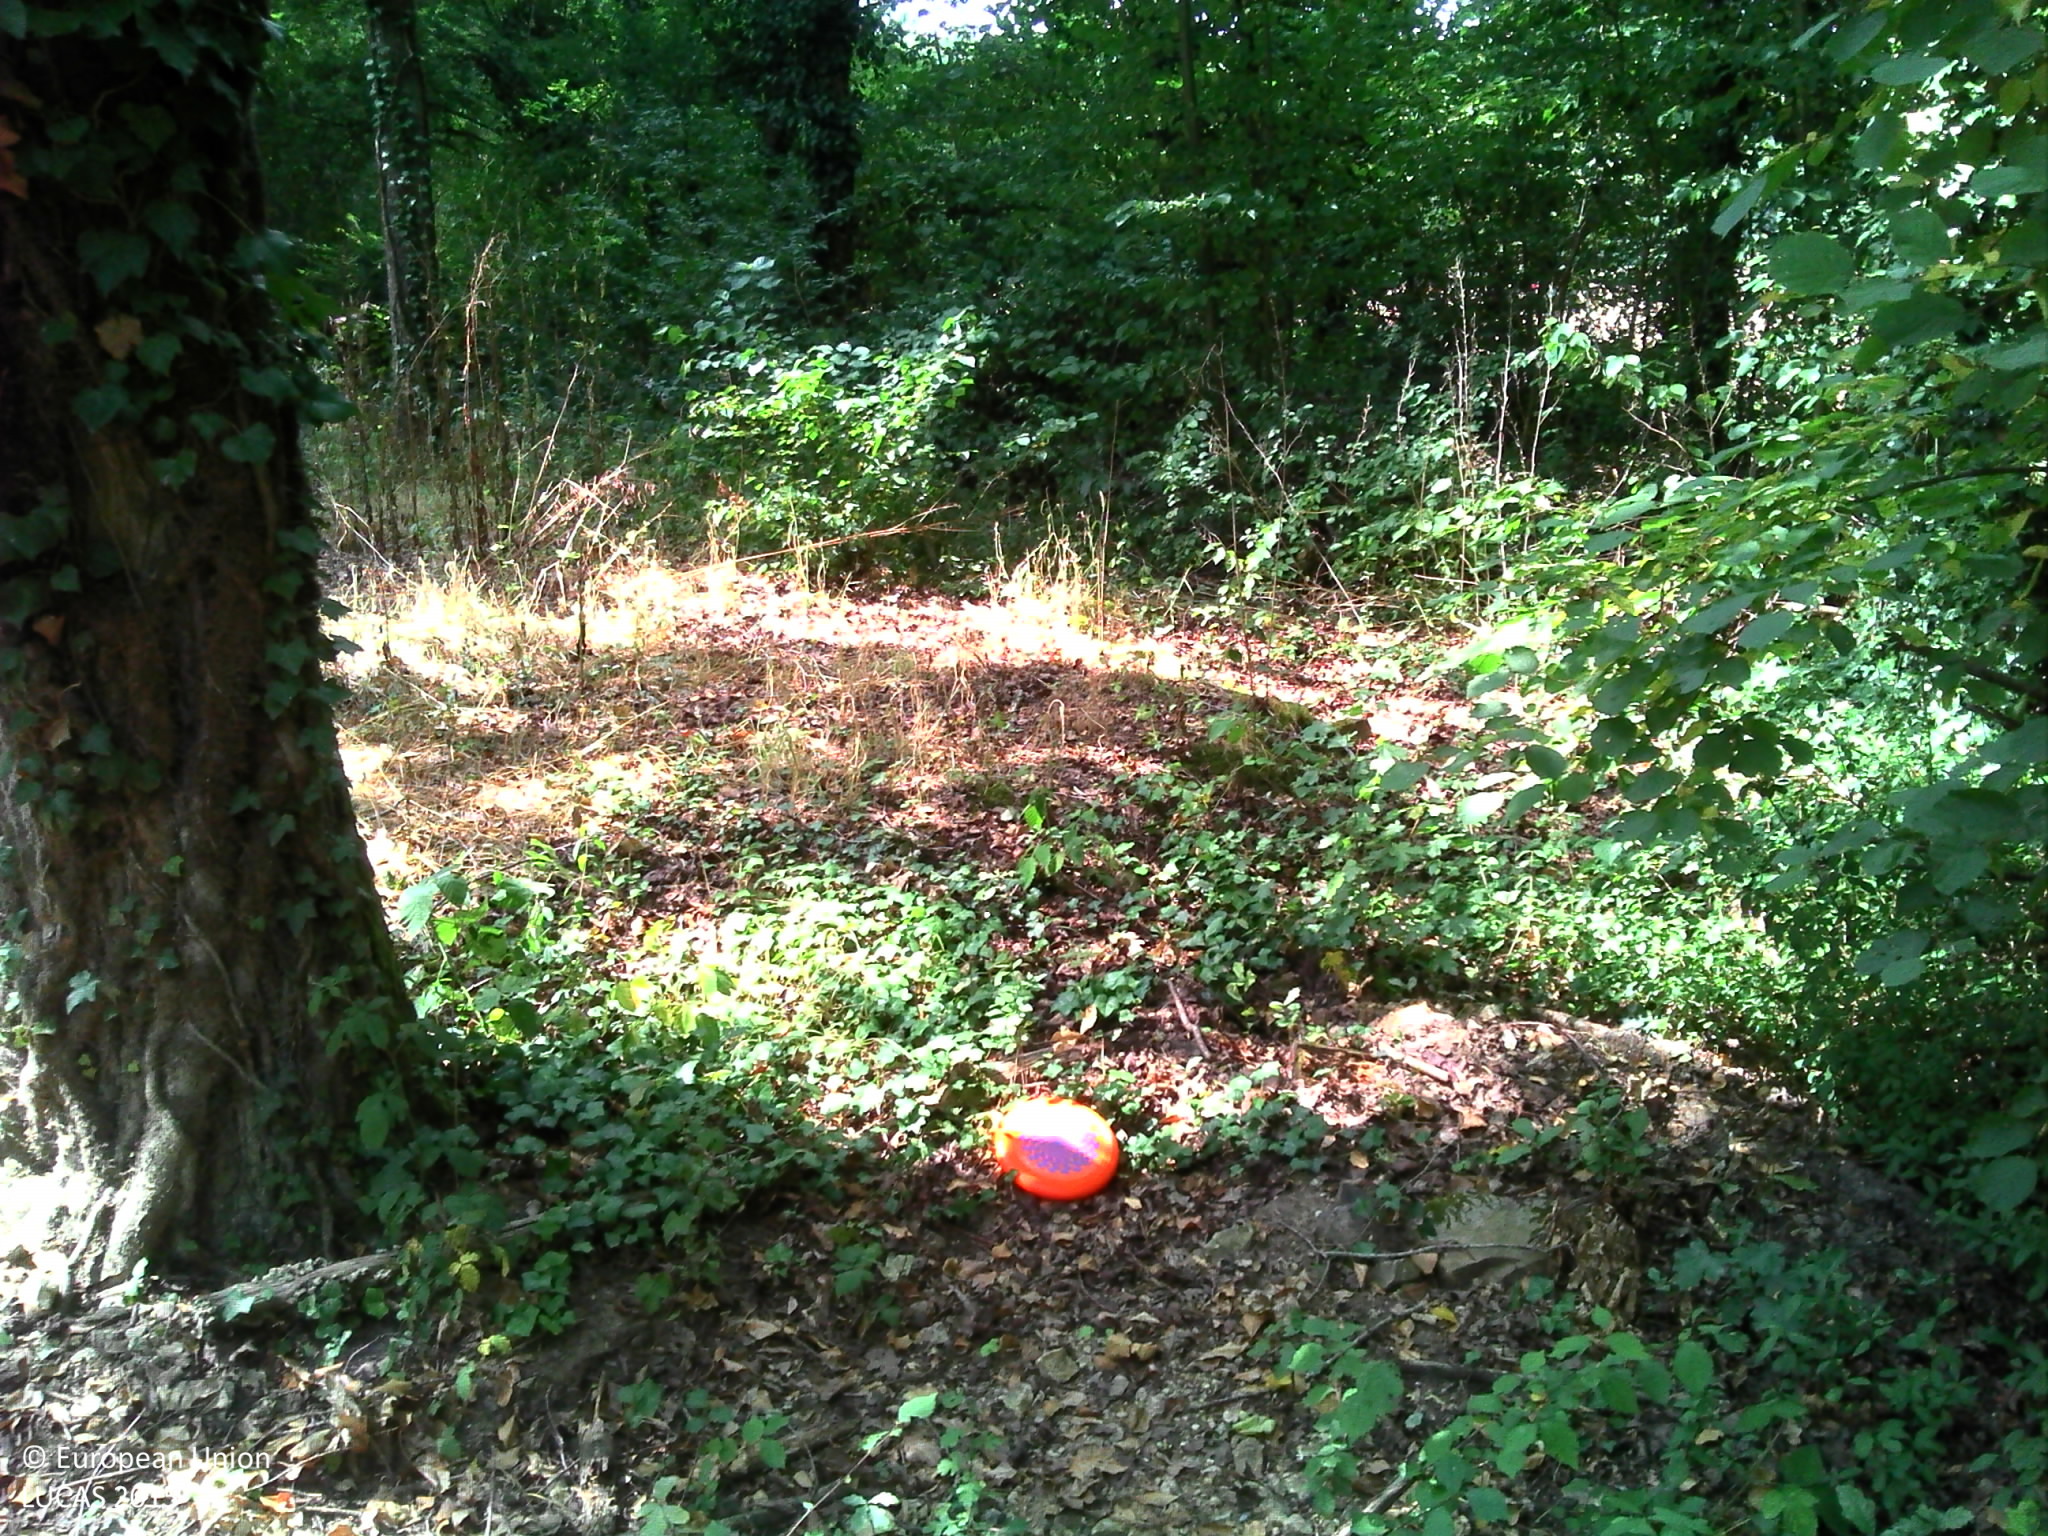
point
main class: Woodland
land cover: Broadleaved woodland
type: beech forest
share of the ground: > 75 %
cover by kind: broadleaved forest trees 55 %, herbaceous plants 35 %, shrubs 5 %, unconsolidated bare surface 5 %
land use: Residential
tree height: > 5 m
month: August
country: FR
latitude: 48.3635
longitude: 2.4714
